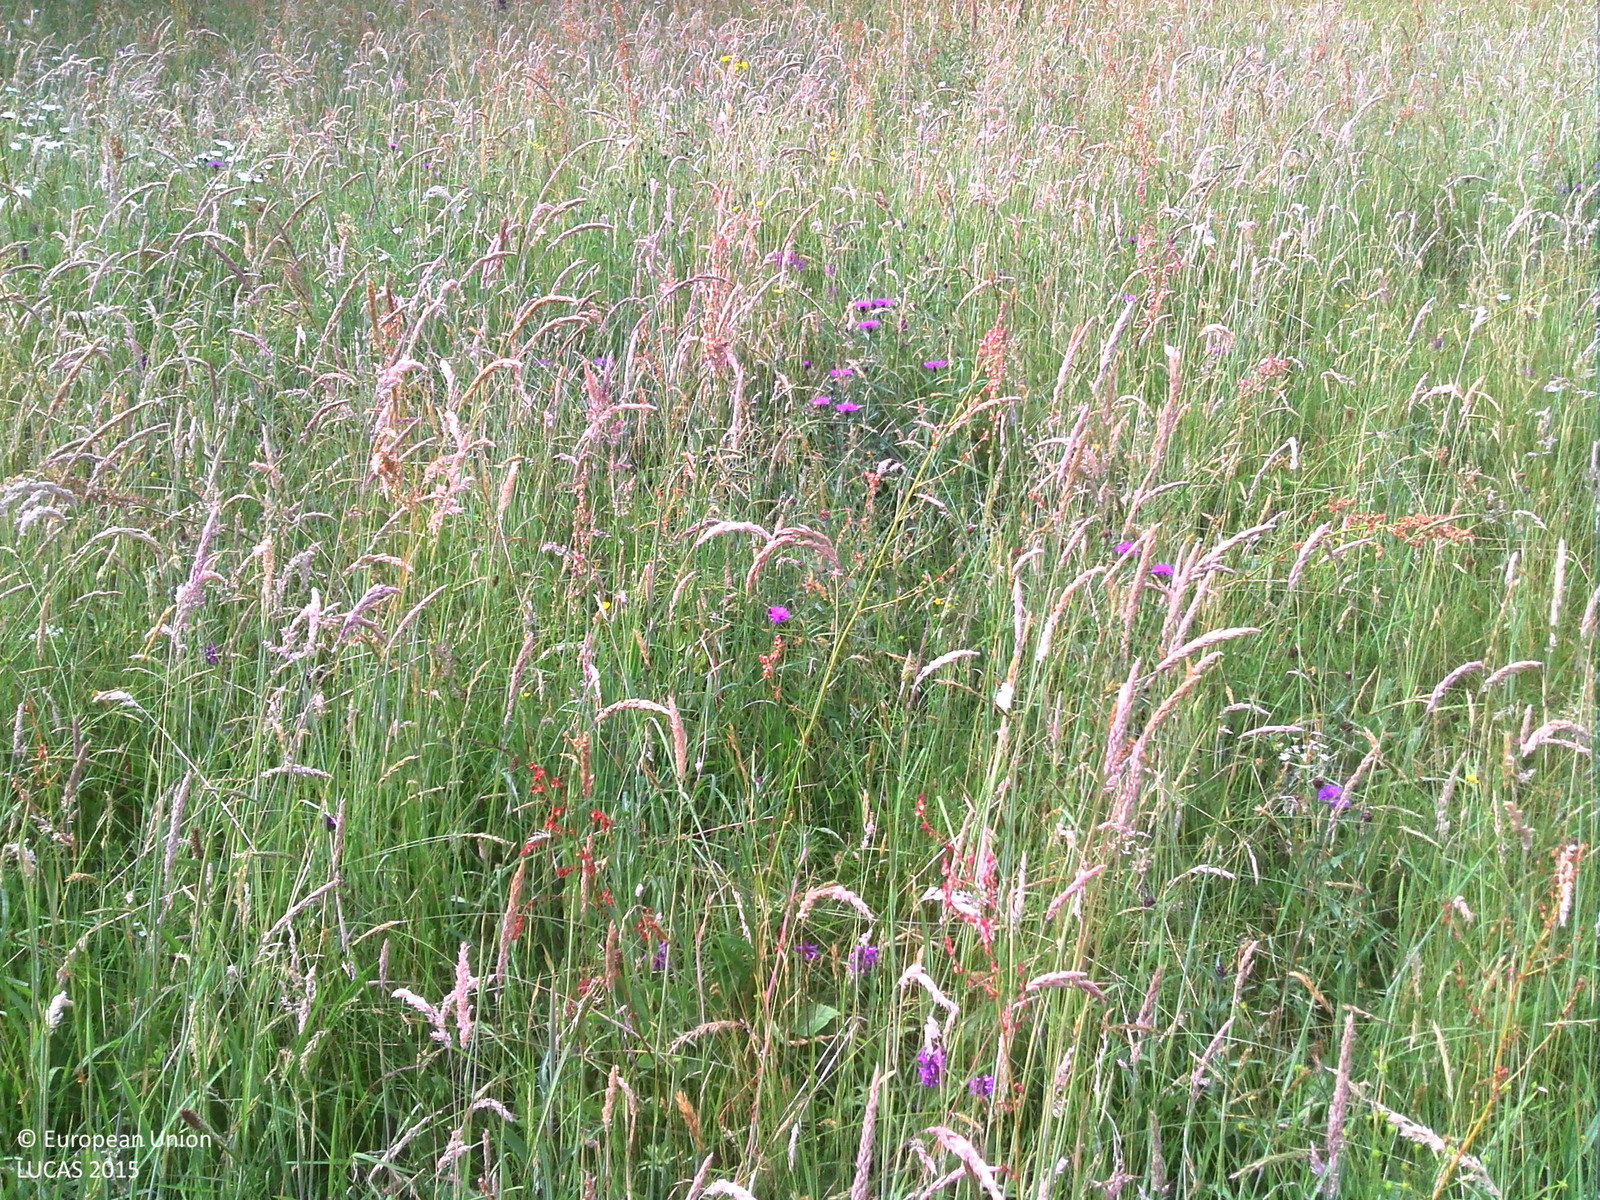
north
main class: Grassland
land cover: Grassland without tree/shrub cover
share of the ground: > 75 %
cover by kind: herbaceous plants 100 %
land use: Agriculture (excluding fallow land and kitchen gardens)
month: June
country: BE
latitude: 50.3937
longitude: 5.7646
